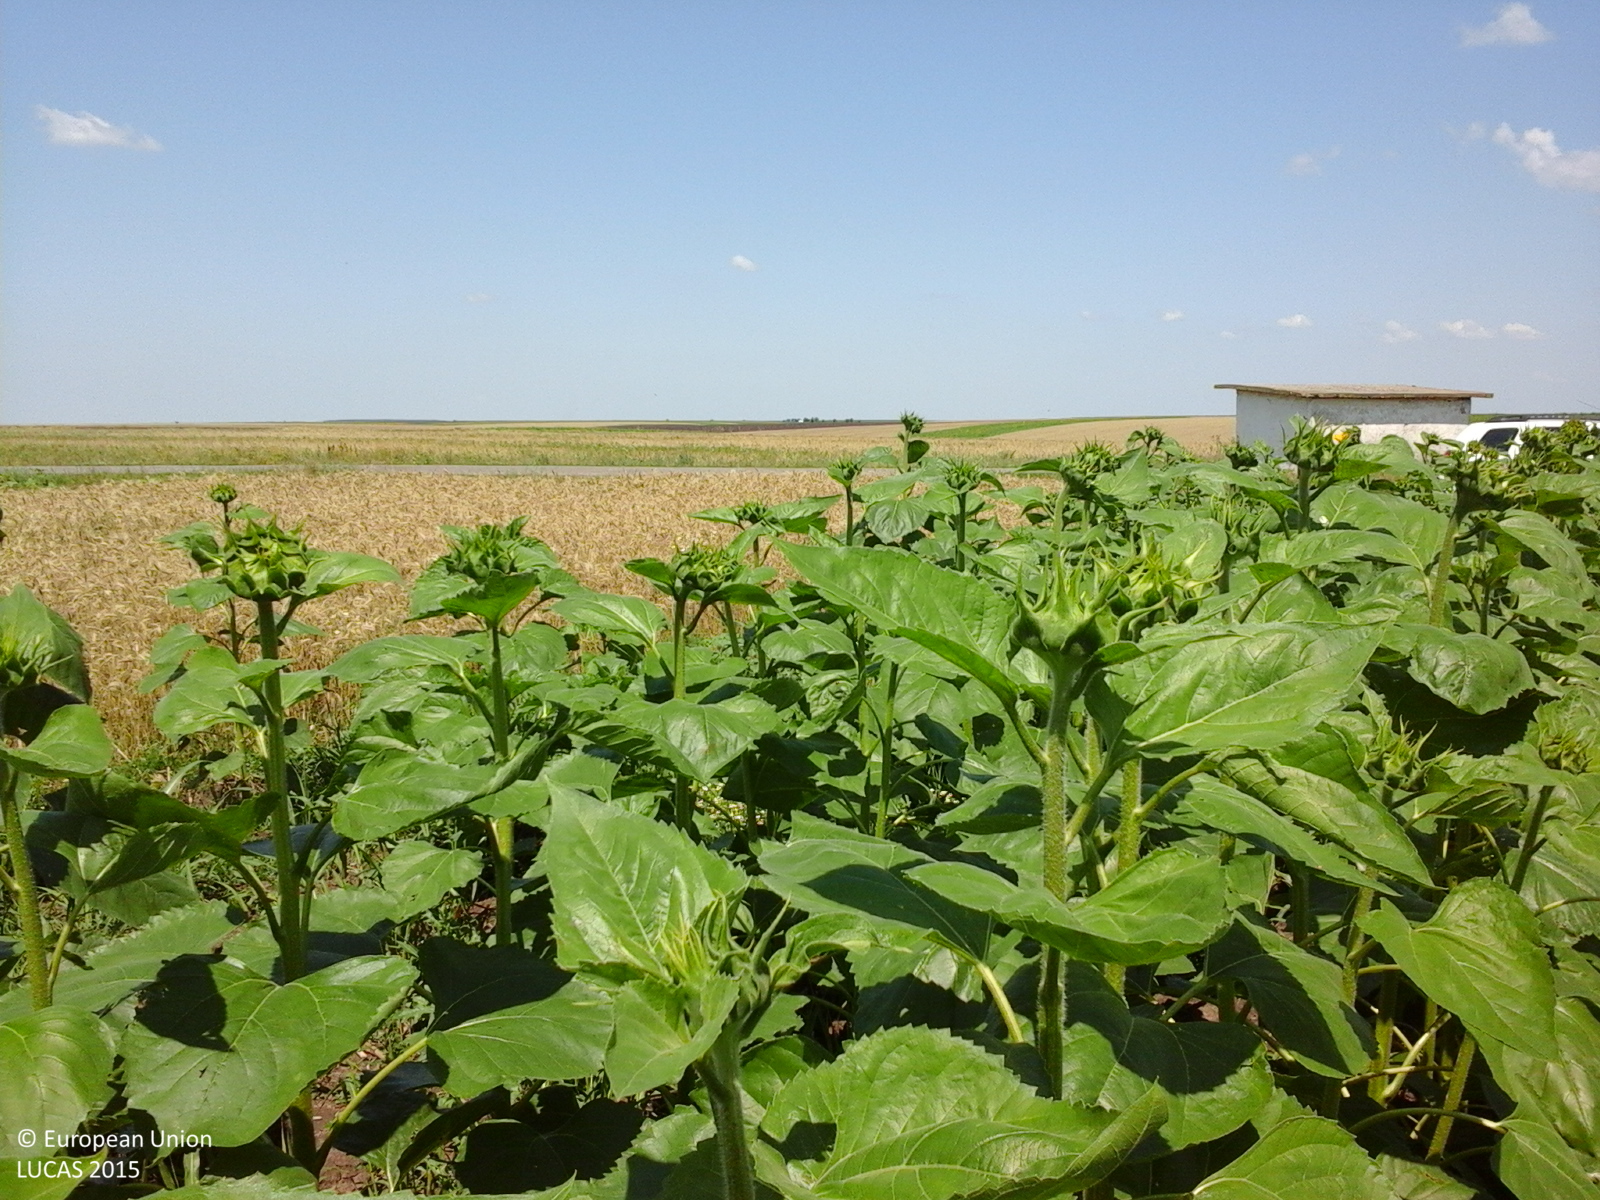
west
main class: Cropland
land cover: Sunflower
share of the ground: > 75 %
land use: Agriculture (excluding fallow land and kitchen gardens)
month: July
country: RO
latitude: 44.2013
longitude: 24.7768
